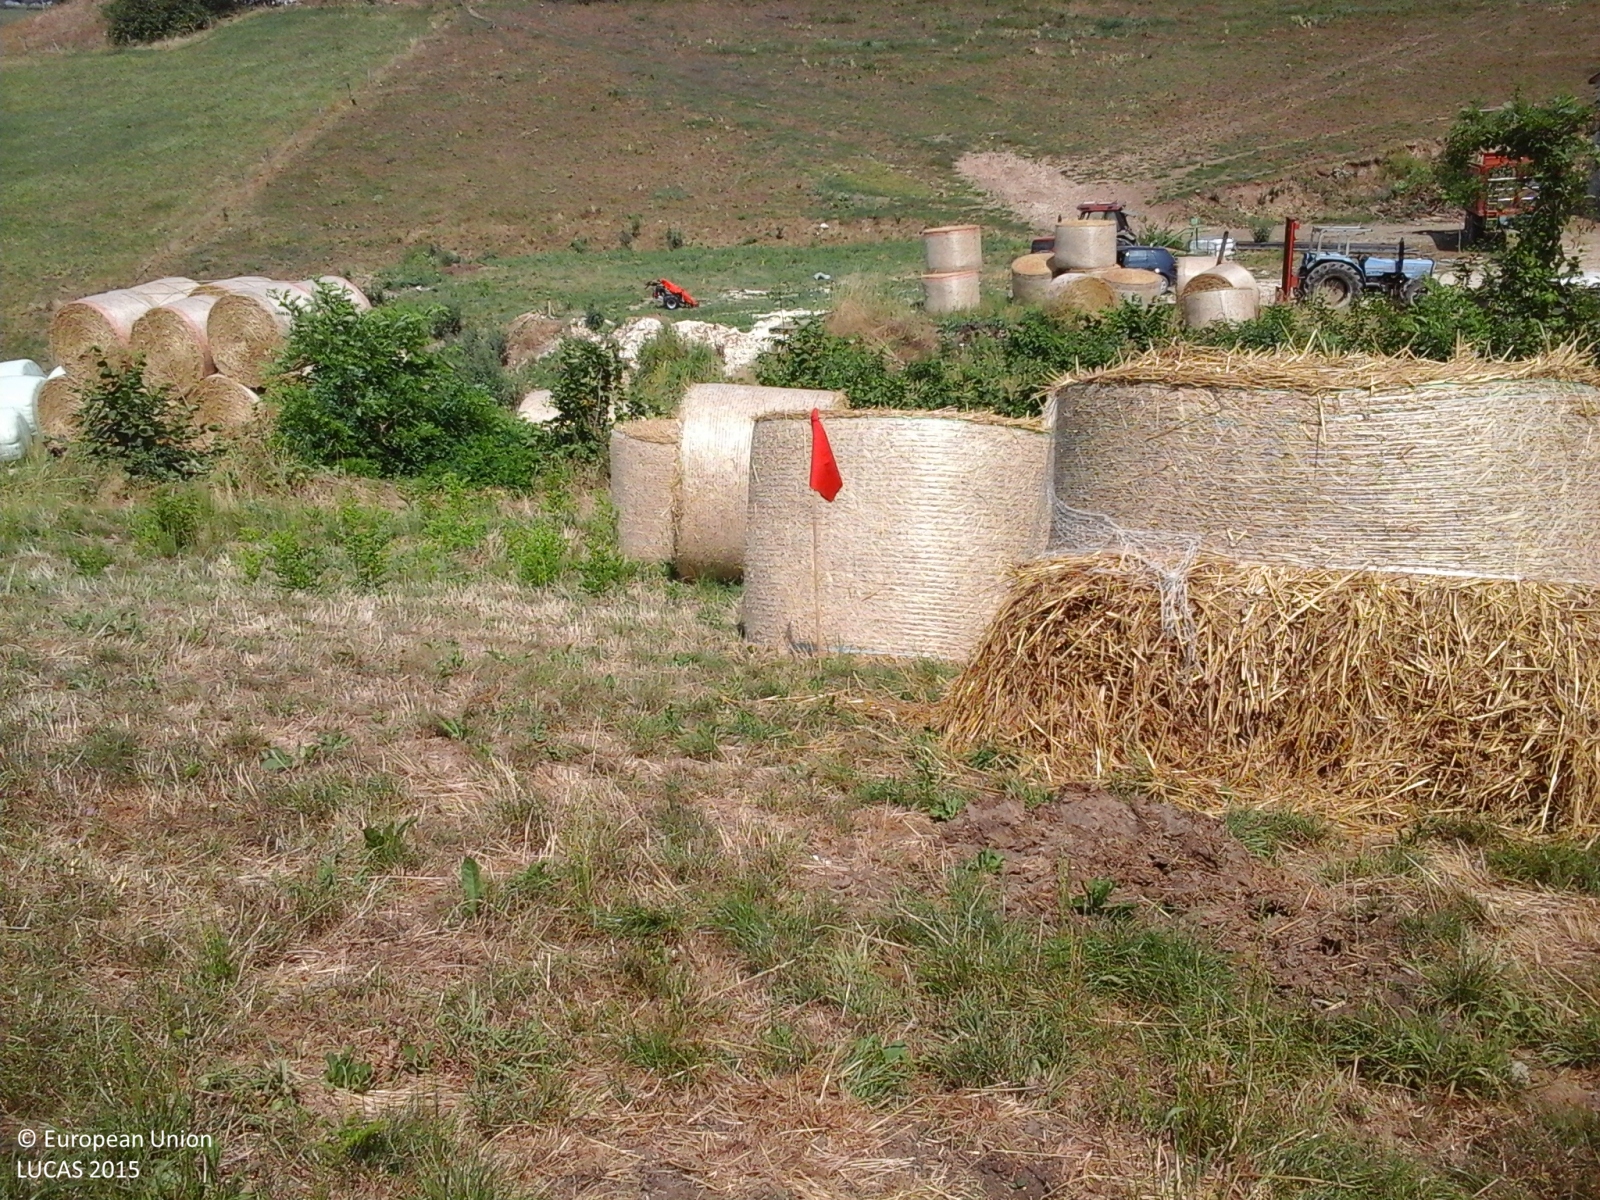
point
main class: Grassland
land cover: Grassland without tree/shrub cover
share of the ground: > 75 %
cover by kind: herbaceous plants 100 %
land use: Agriculture (excluding fallow land and kitchen gardens)
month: July
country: IT
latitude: 45.5706
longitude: 11.1129
